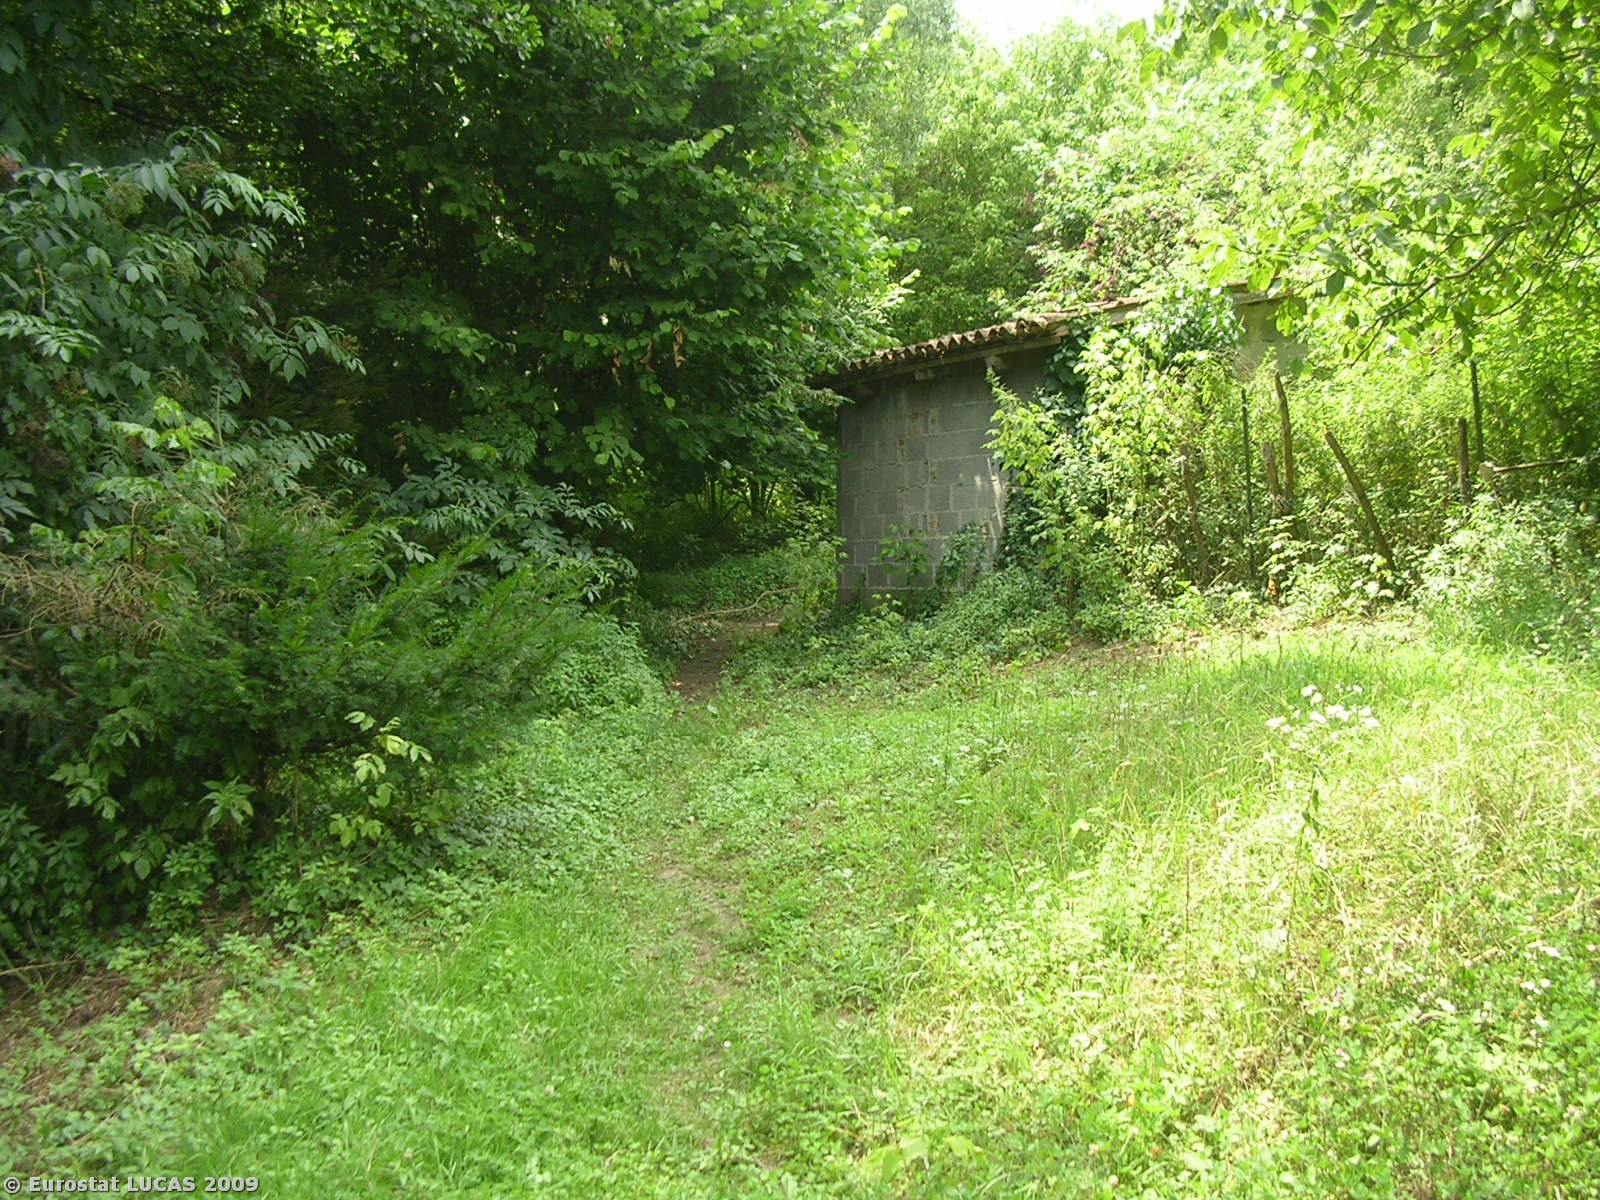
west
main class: Woodland
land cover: Mixed woodland
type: mesophytic deciduous forest
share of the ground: > 75 %
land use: Forestry
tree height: > 5 m
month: July
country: IT
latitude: 45.3102
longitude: 11.7189
